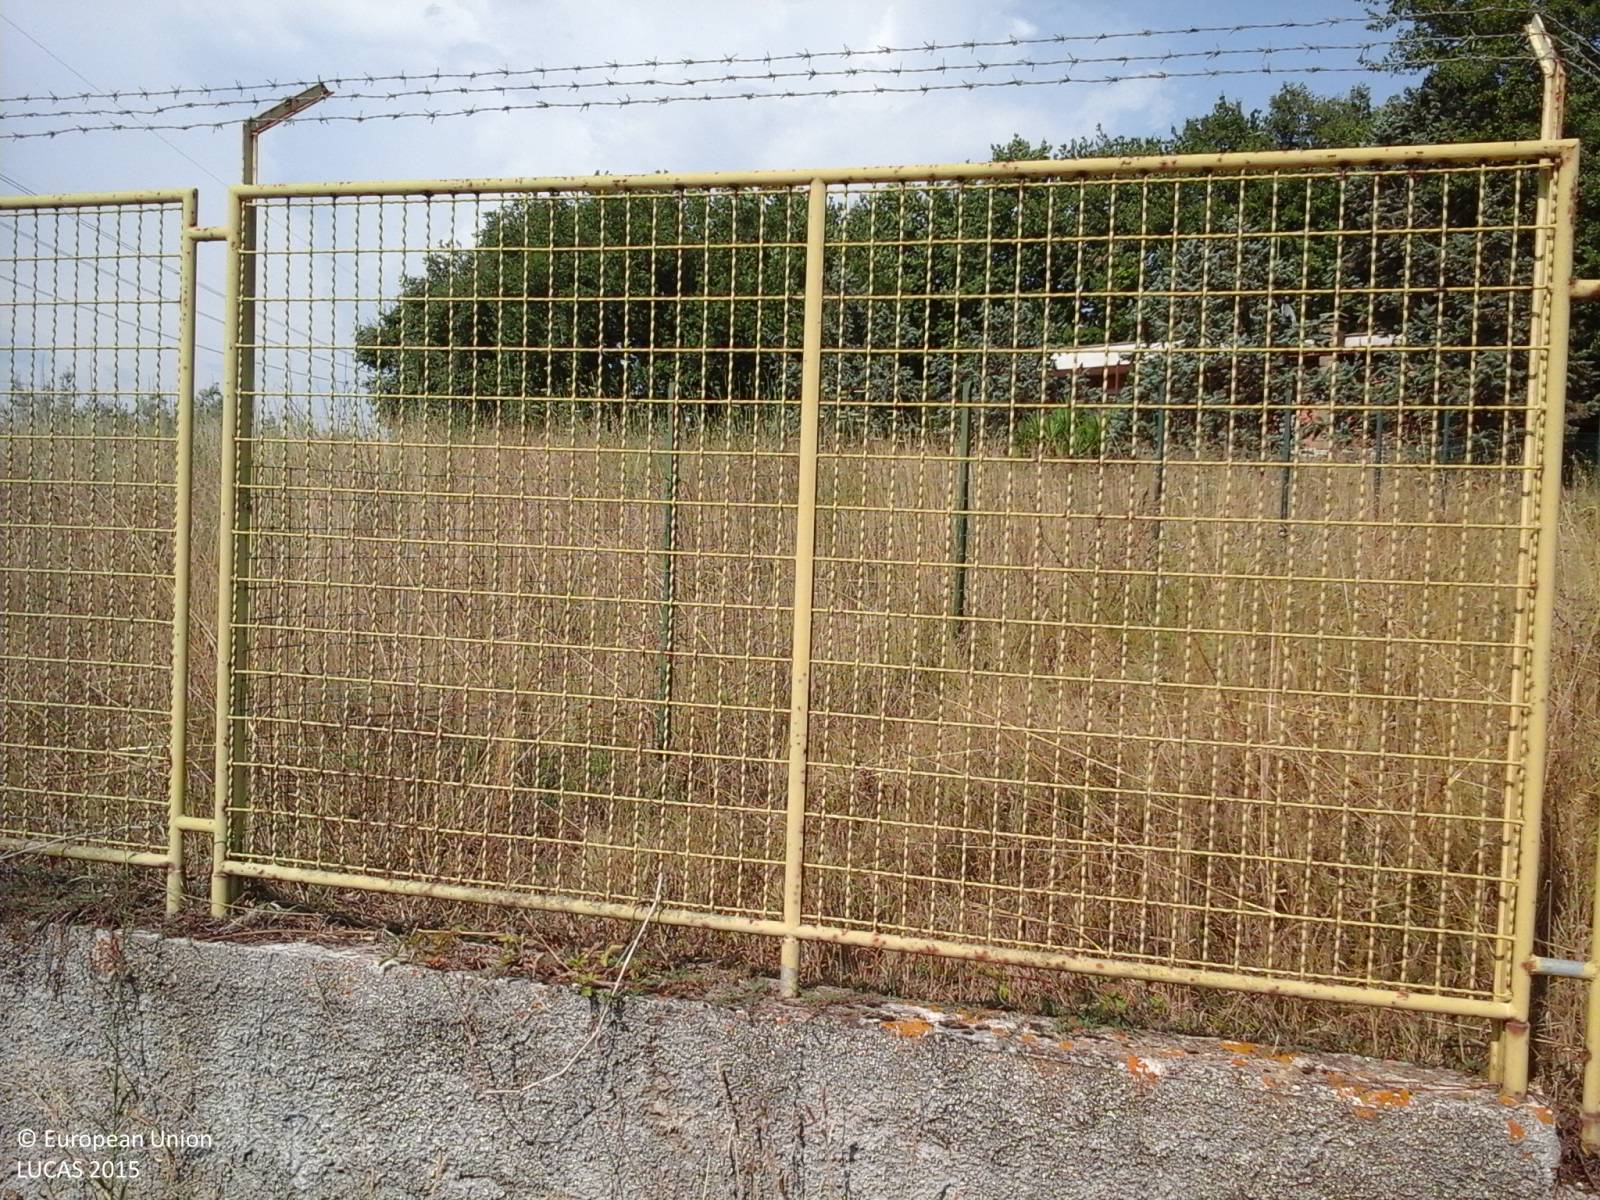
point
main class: Grassland
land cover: Grassland without tree/shrub cover
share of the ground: > 75 %
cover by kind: herbaceous plants 100 %
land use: Manufacturing of food, beverages and tobacco products
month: July
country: IT
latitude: 42.0677
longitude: 12.3000
